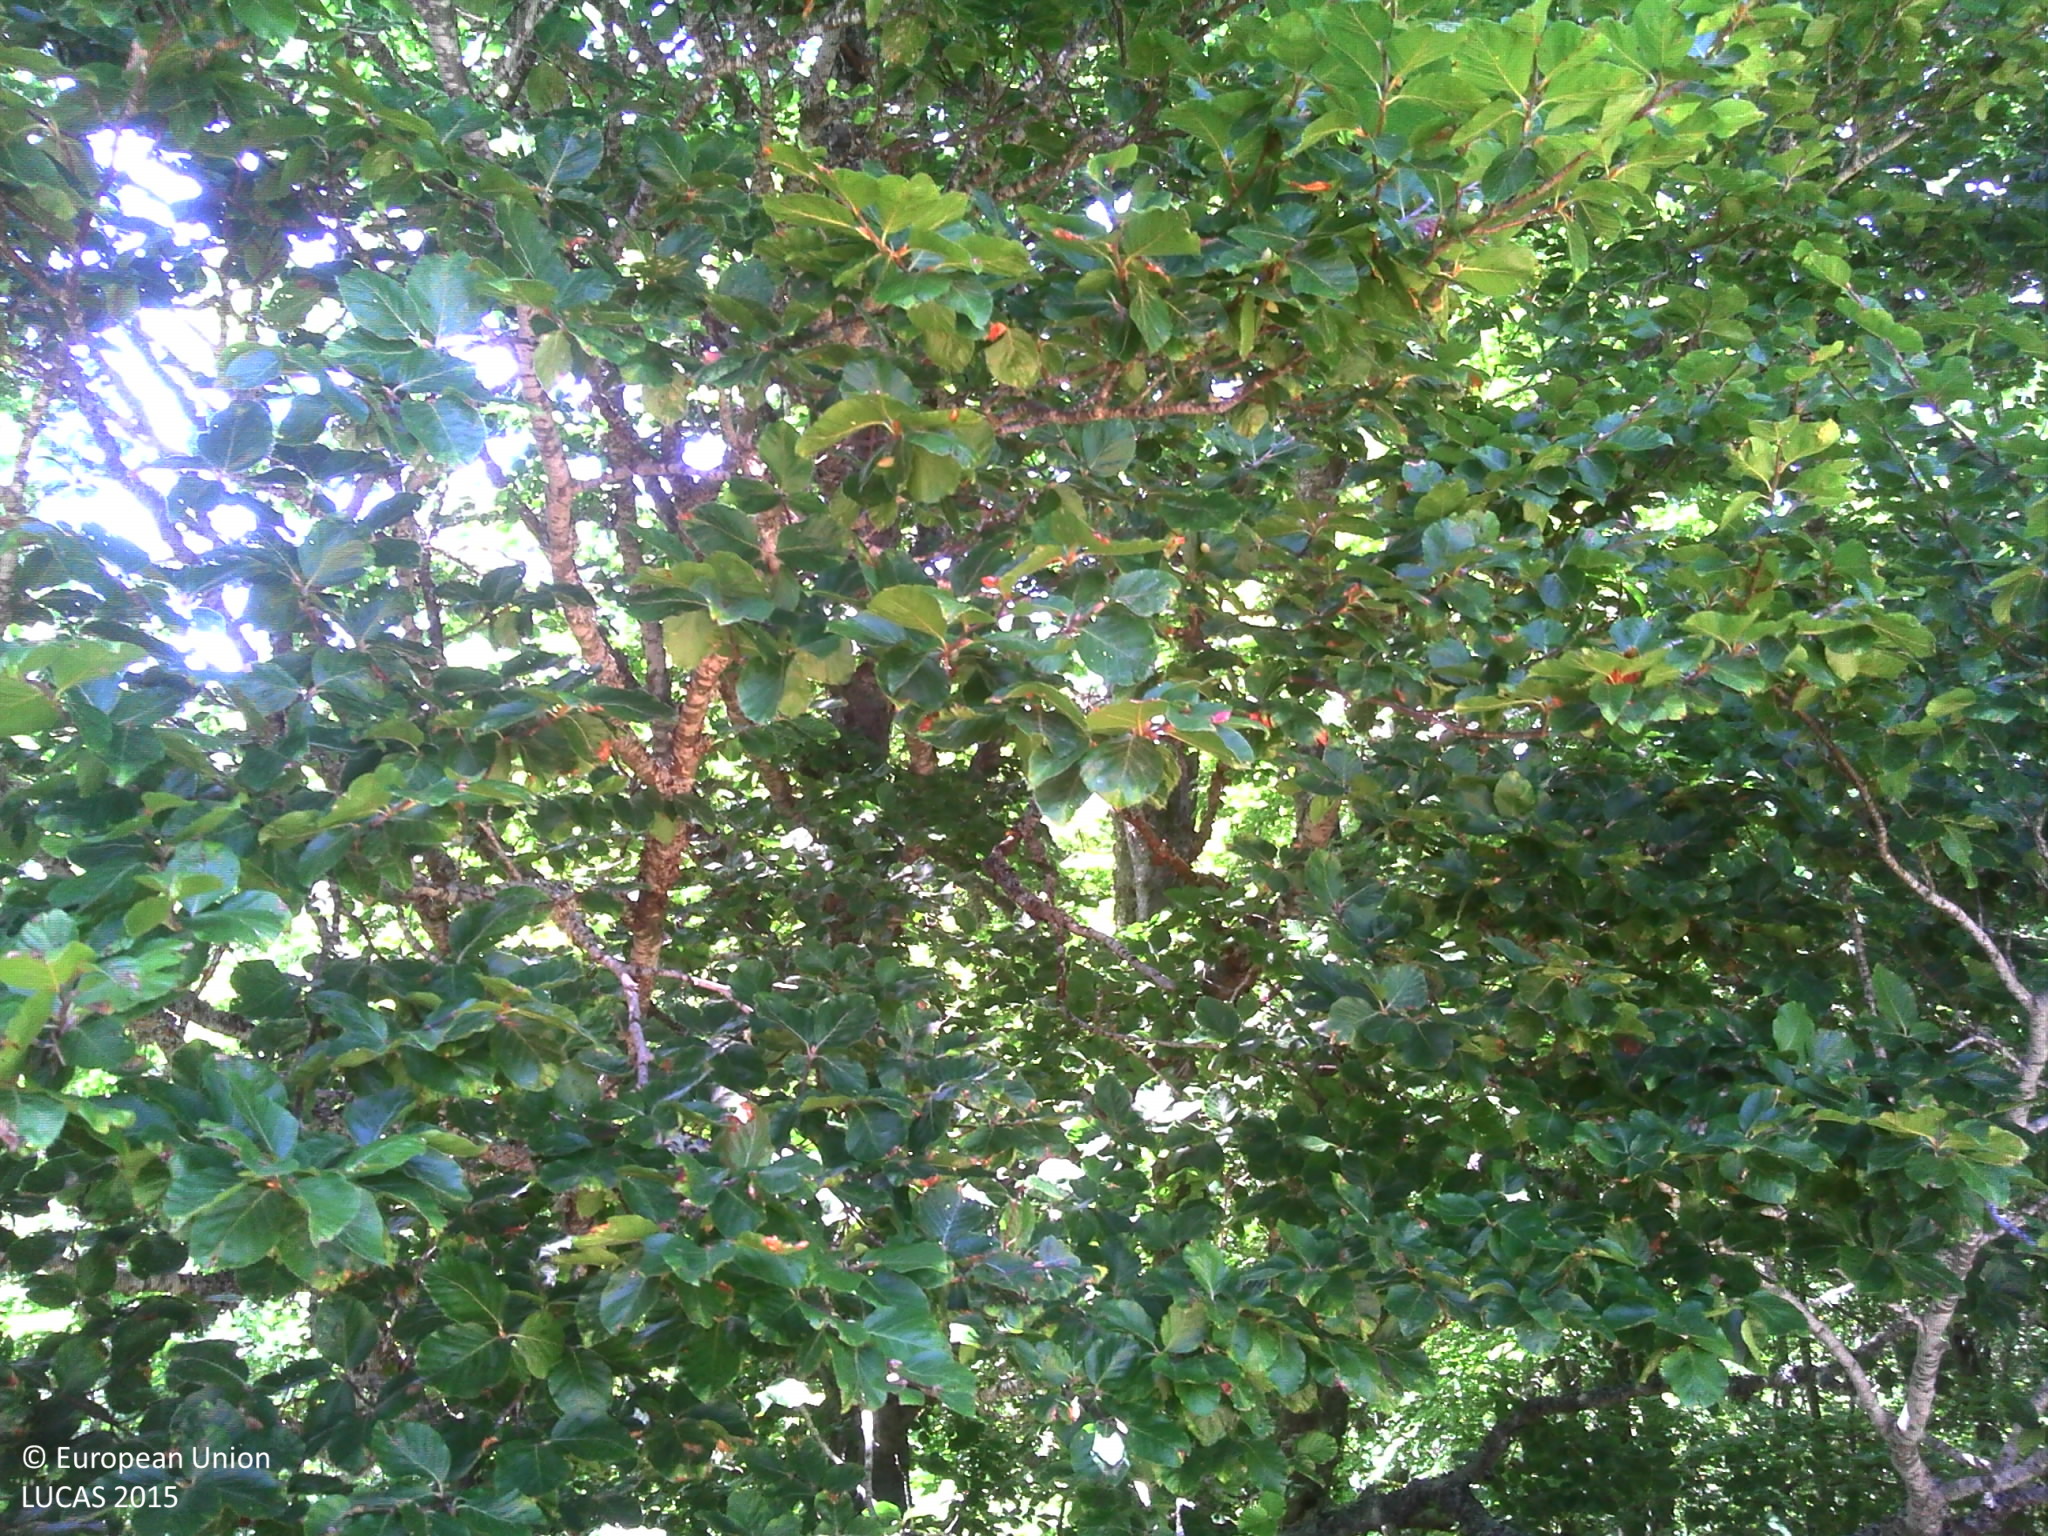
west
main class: Grassland
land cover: Grassland without tree/shrub cover
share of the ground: > 75 %
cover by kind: herbaceous plants 95 %, shrubs 5 %
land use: Agriculture (excluding fallow land and kitchen gardens)
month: July
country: FR
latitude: 44.7045
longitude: 3.4540
